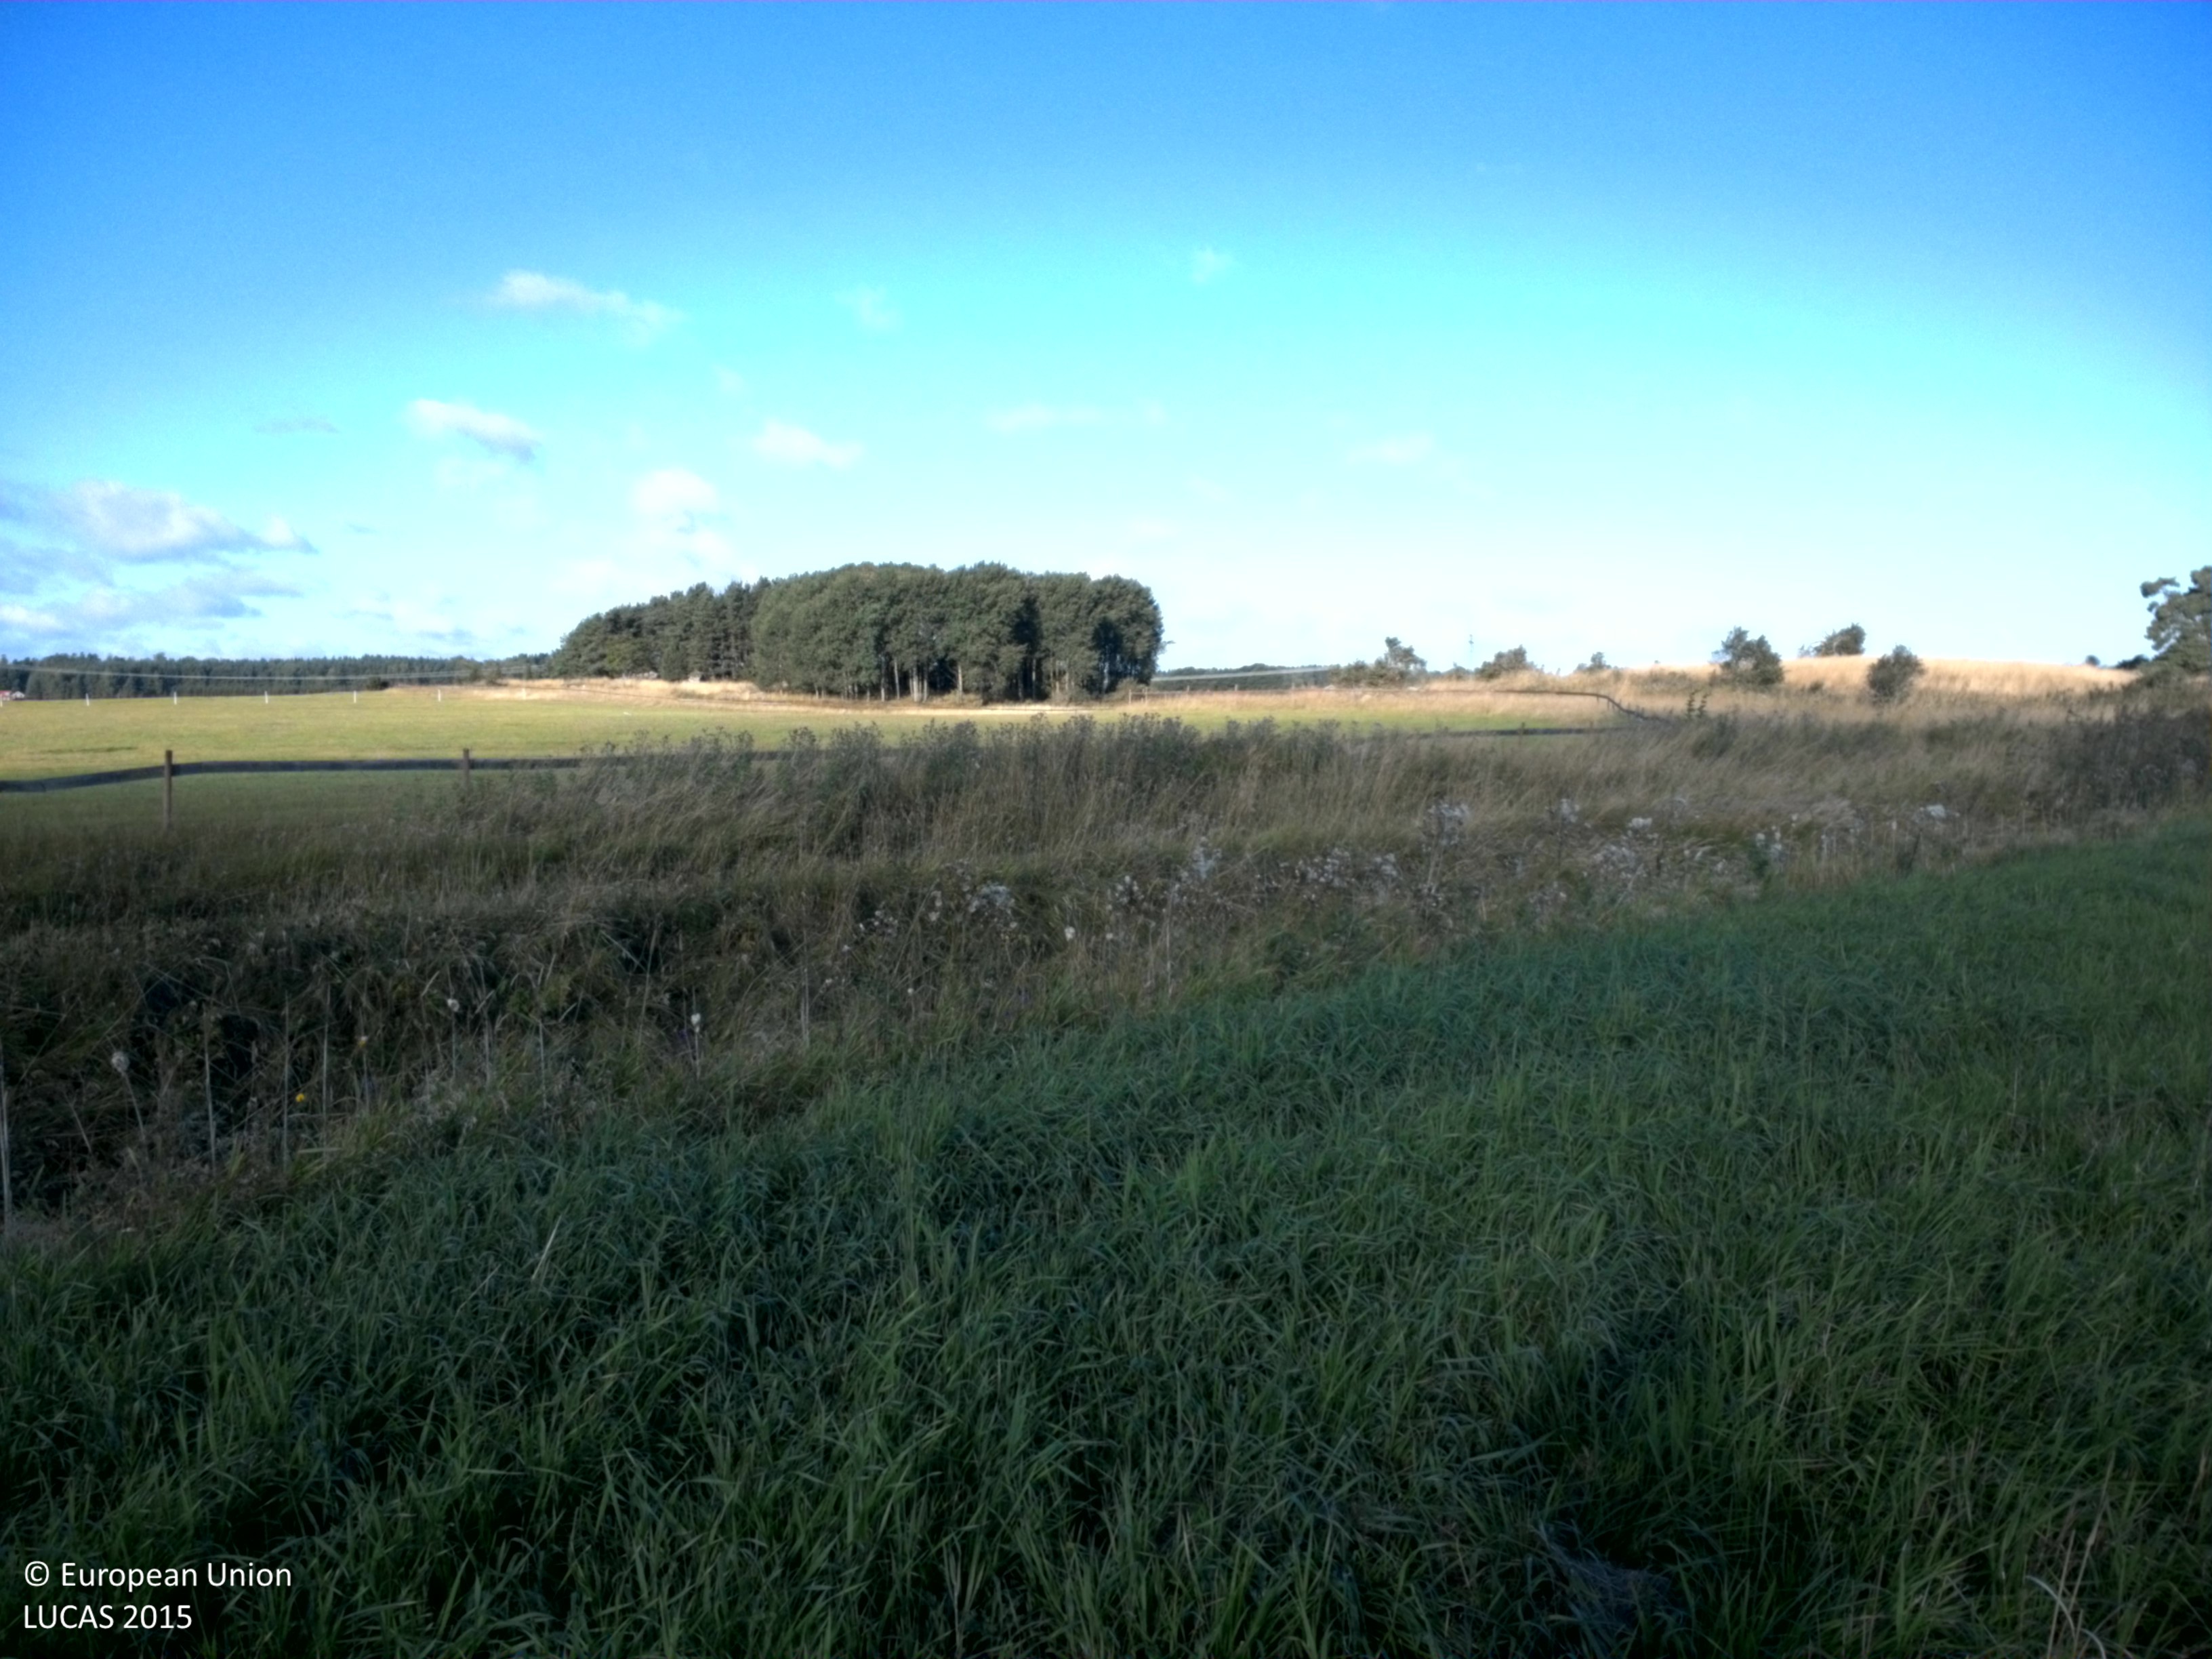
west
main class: Grassland
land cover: Grassland without tree/shrub cover
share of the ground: > 75 %
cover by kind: herbaceous plants 100 %
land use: Agriculture (excluding fallow land and kitchen gardens)
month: August
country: SE
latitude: 59.6881
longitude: 17.2233
